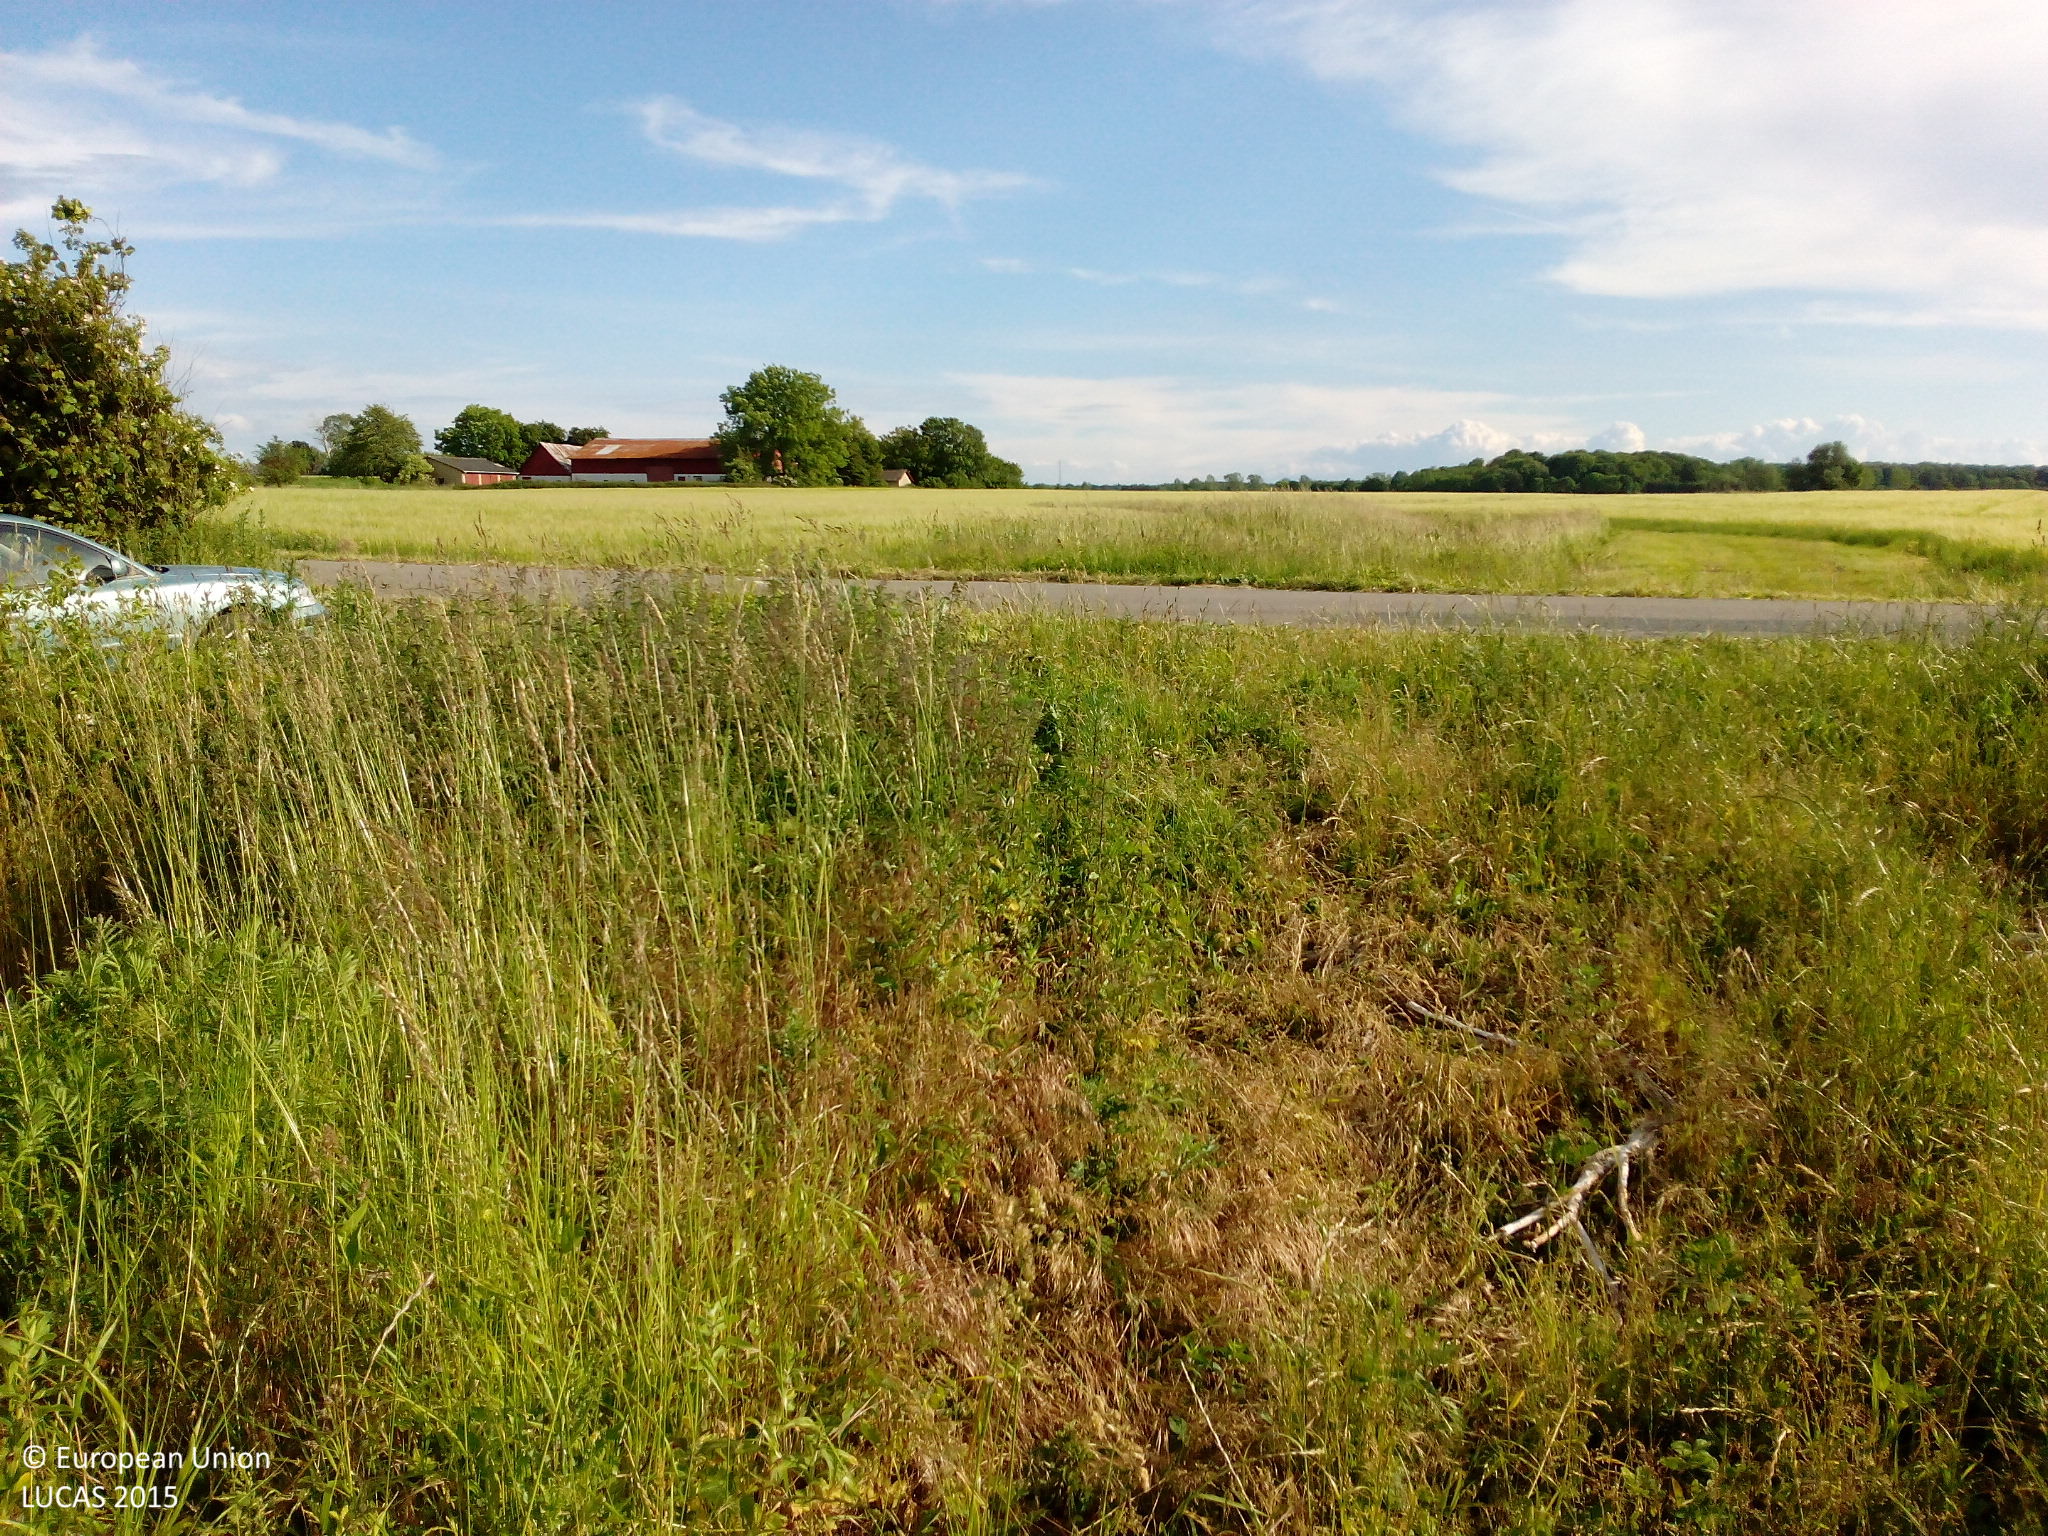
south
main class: Grassland
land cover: Spontaneously vegetated surfaces
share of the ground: > 75 %
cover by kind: herbaceous plants 100 %
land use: Semi-natural and natural areas not in use
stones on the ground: < 10 %
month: June
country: DK
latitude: 54.7555
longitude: 11.7547
